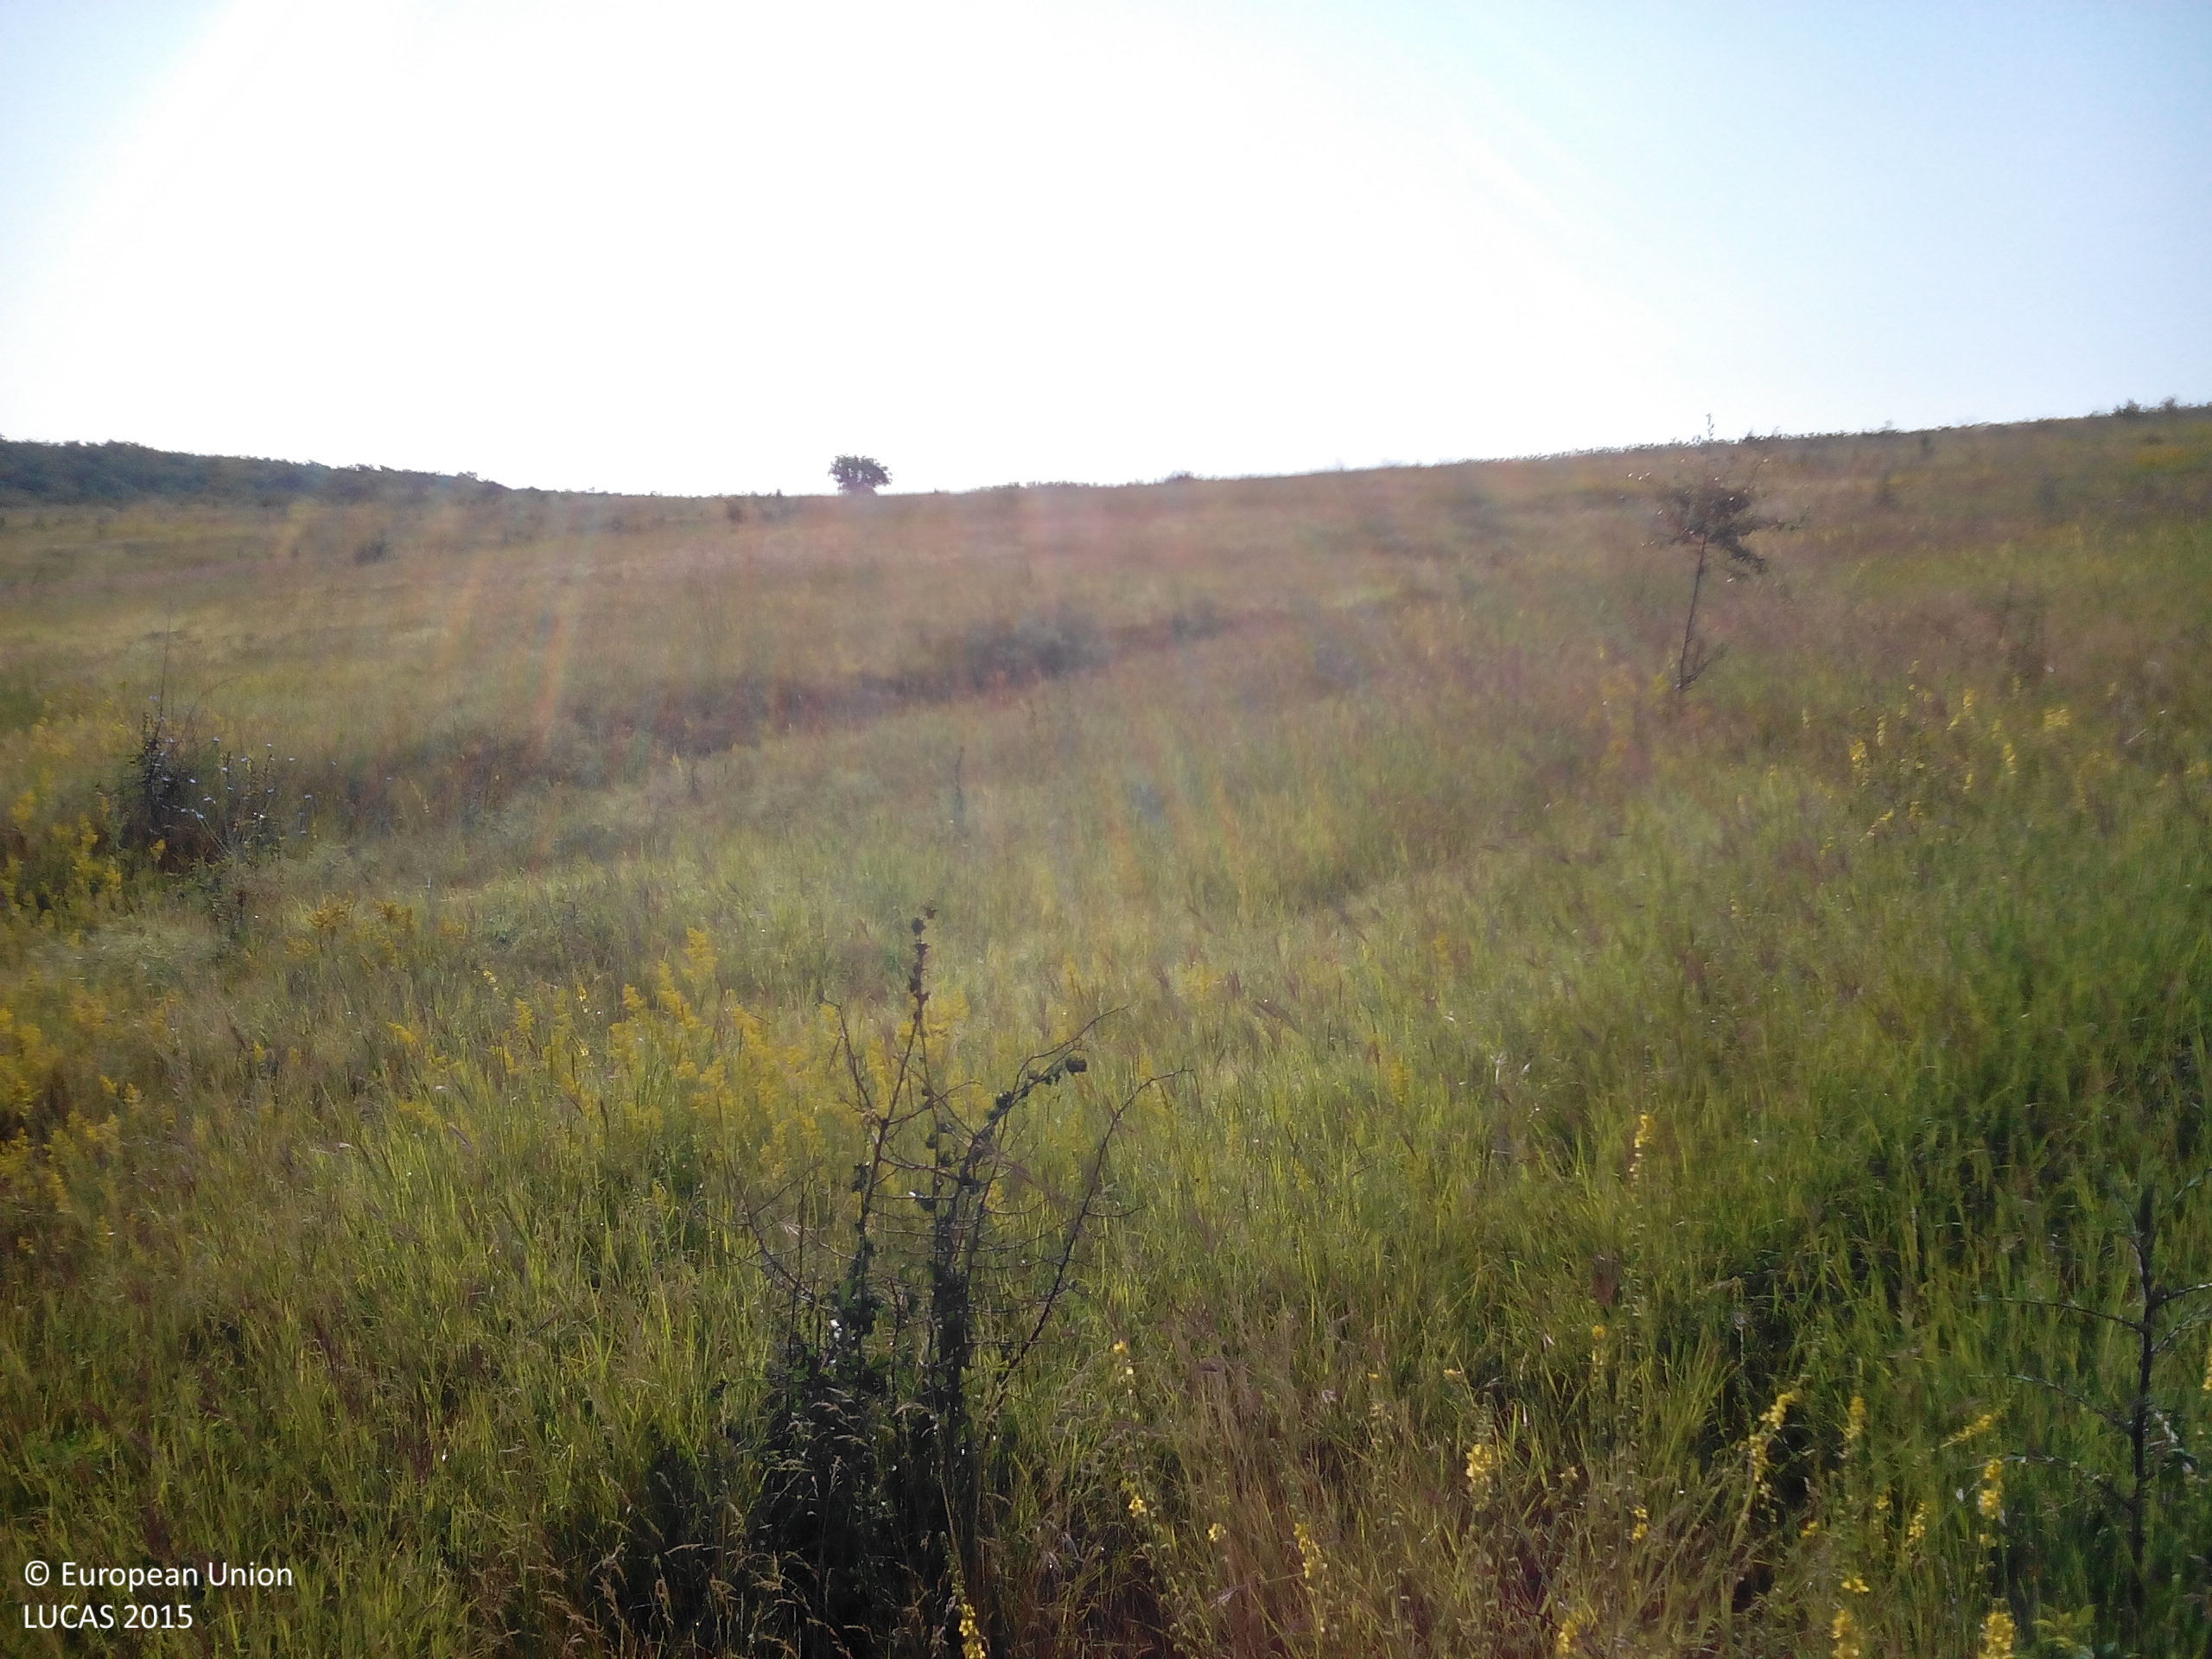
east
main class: Grassland
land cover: Spontaneously vegetated surfaces
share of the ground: > 75 %
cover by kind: herbaceous plants 95 %, shrubs 5 %
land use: Abandoned areas
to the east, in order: Spontaneously vegetated surfaces; Rivers and streams; Sunflower; Spontaneously vegetated surfaces
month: July
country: BG
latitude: 43.3458
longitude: 24.2294
